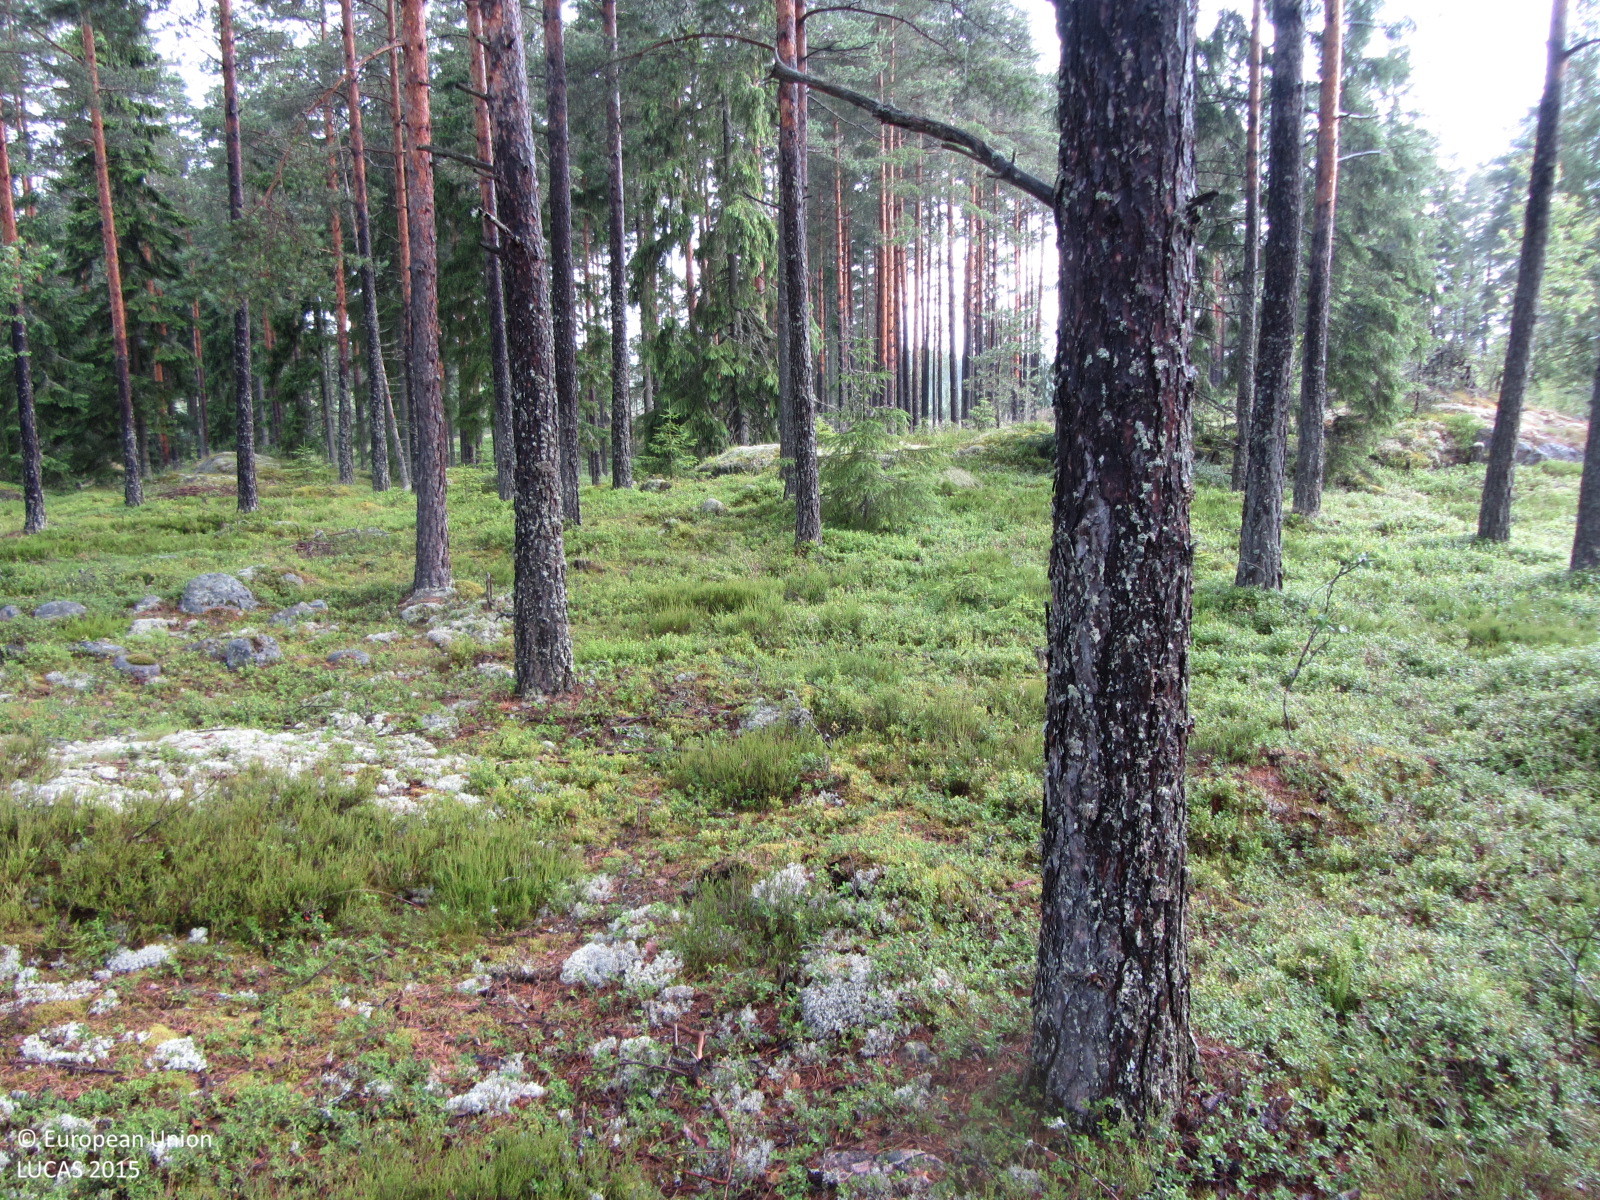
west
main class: Woodland
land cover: Pine dominated coniferous woodland
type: boreal forest
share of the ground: 50 - 75 %
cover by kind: coniferous forest trees 50 %, shrubs 30 %, lichens and mosses 20 %
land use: Forestry
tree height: > 5 m
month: July
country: FI
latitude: 60.0385
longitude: 23.1337
